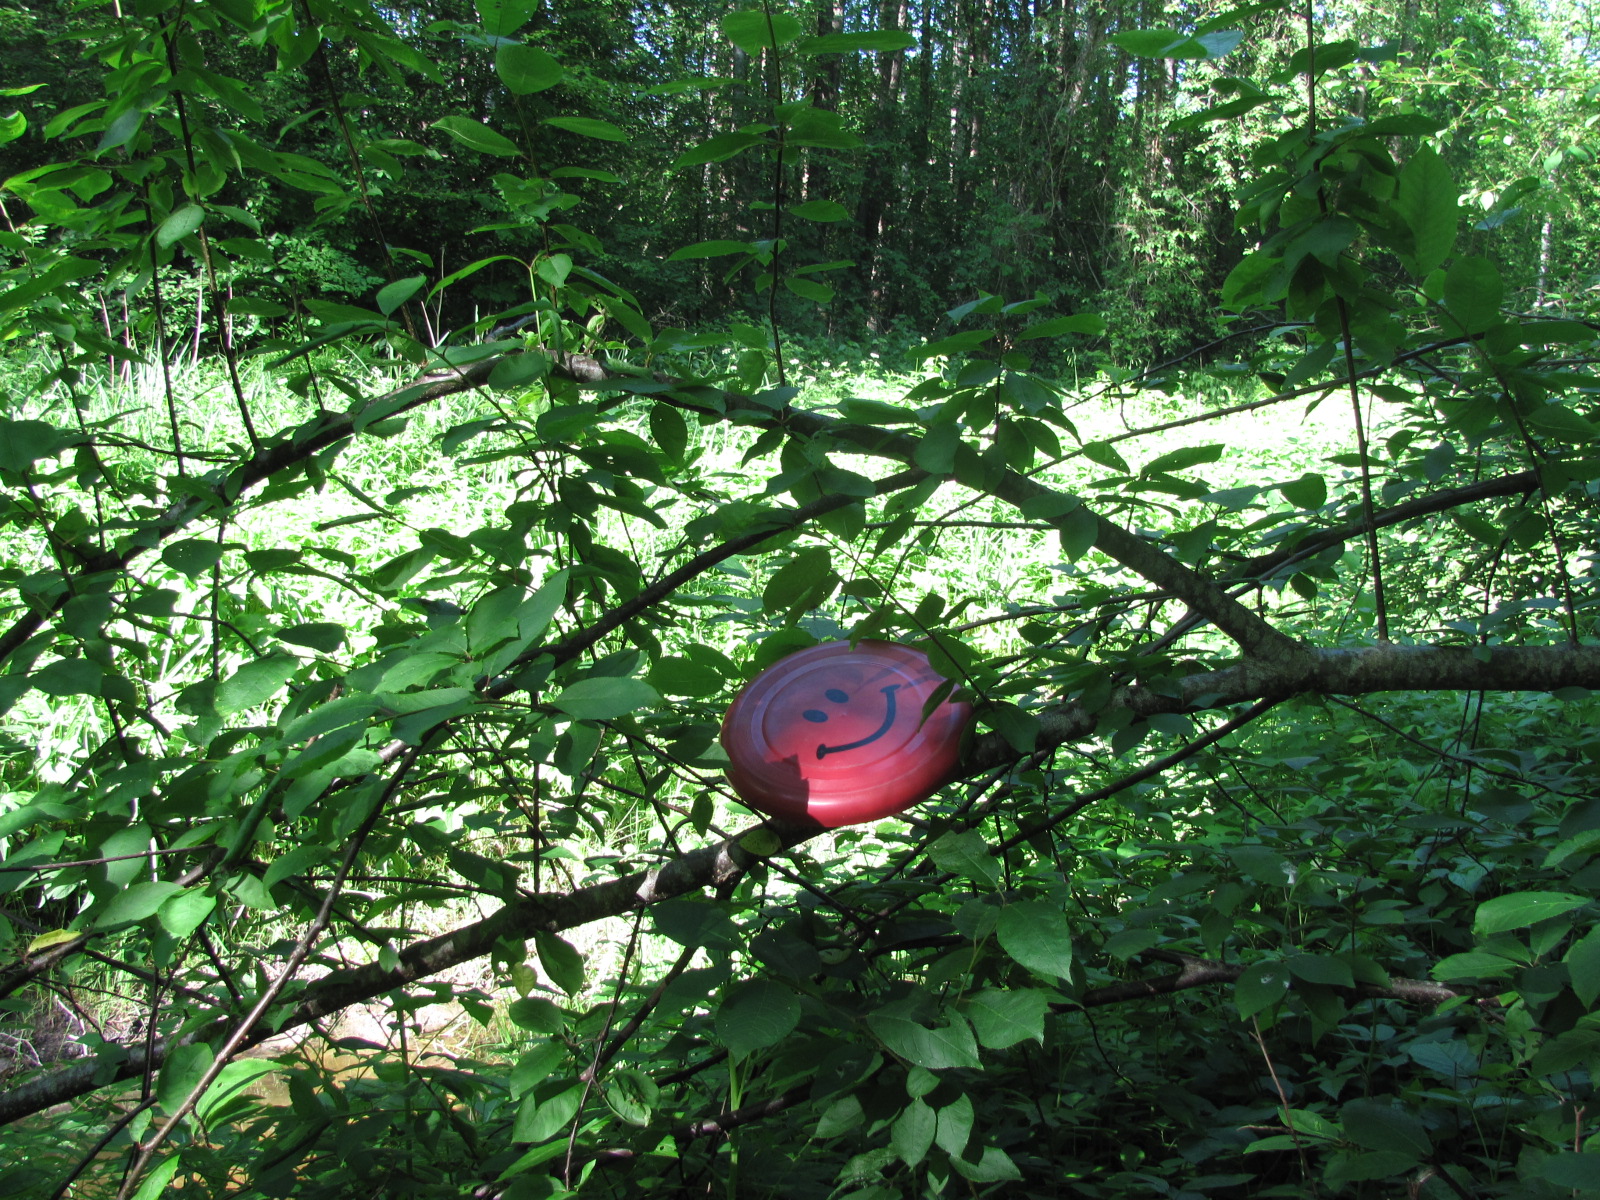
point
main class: Woodland
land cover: Broadleaved woodland
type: non-riverine alder, birch or aspen forest
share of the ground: > 75 %
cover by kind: broadleaved forest trees 100 %
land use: Forestry
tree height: > 5 m
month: June
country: LV
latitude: 56.4861
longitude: 24.2347
